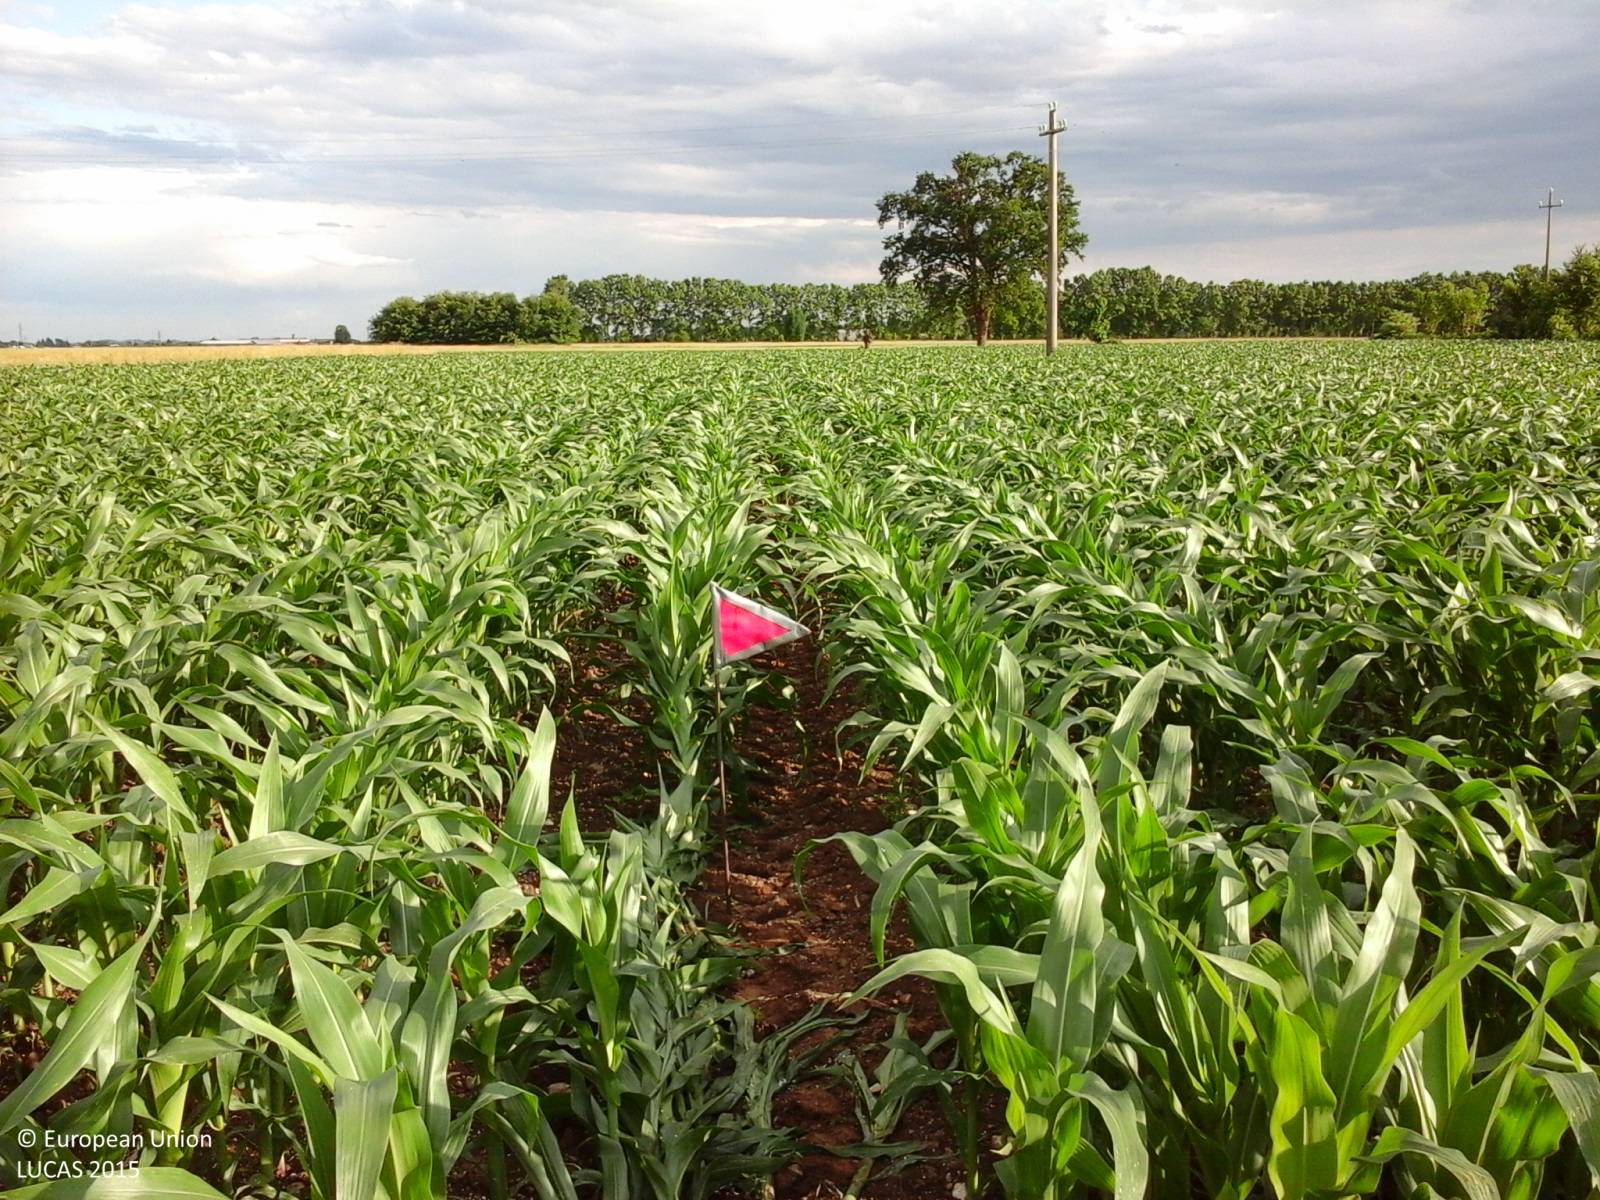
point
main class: Cropland
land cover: Maize
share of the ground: > 75 %
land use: Agriculture (excluding fallow land and kitchen gardens)
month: May
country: IT
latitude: 46.1390
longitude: 13.2716
